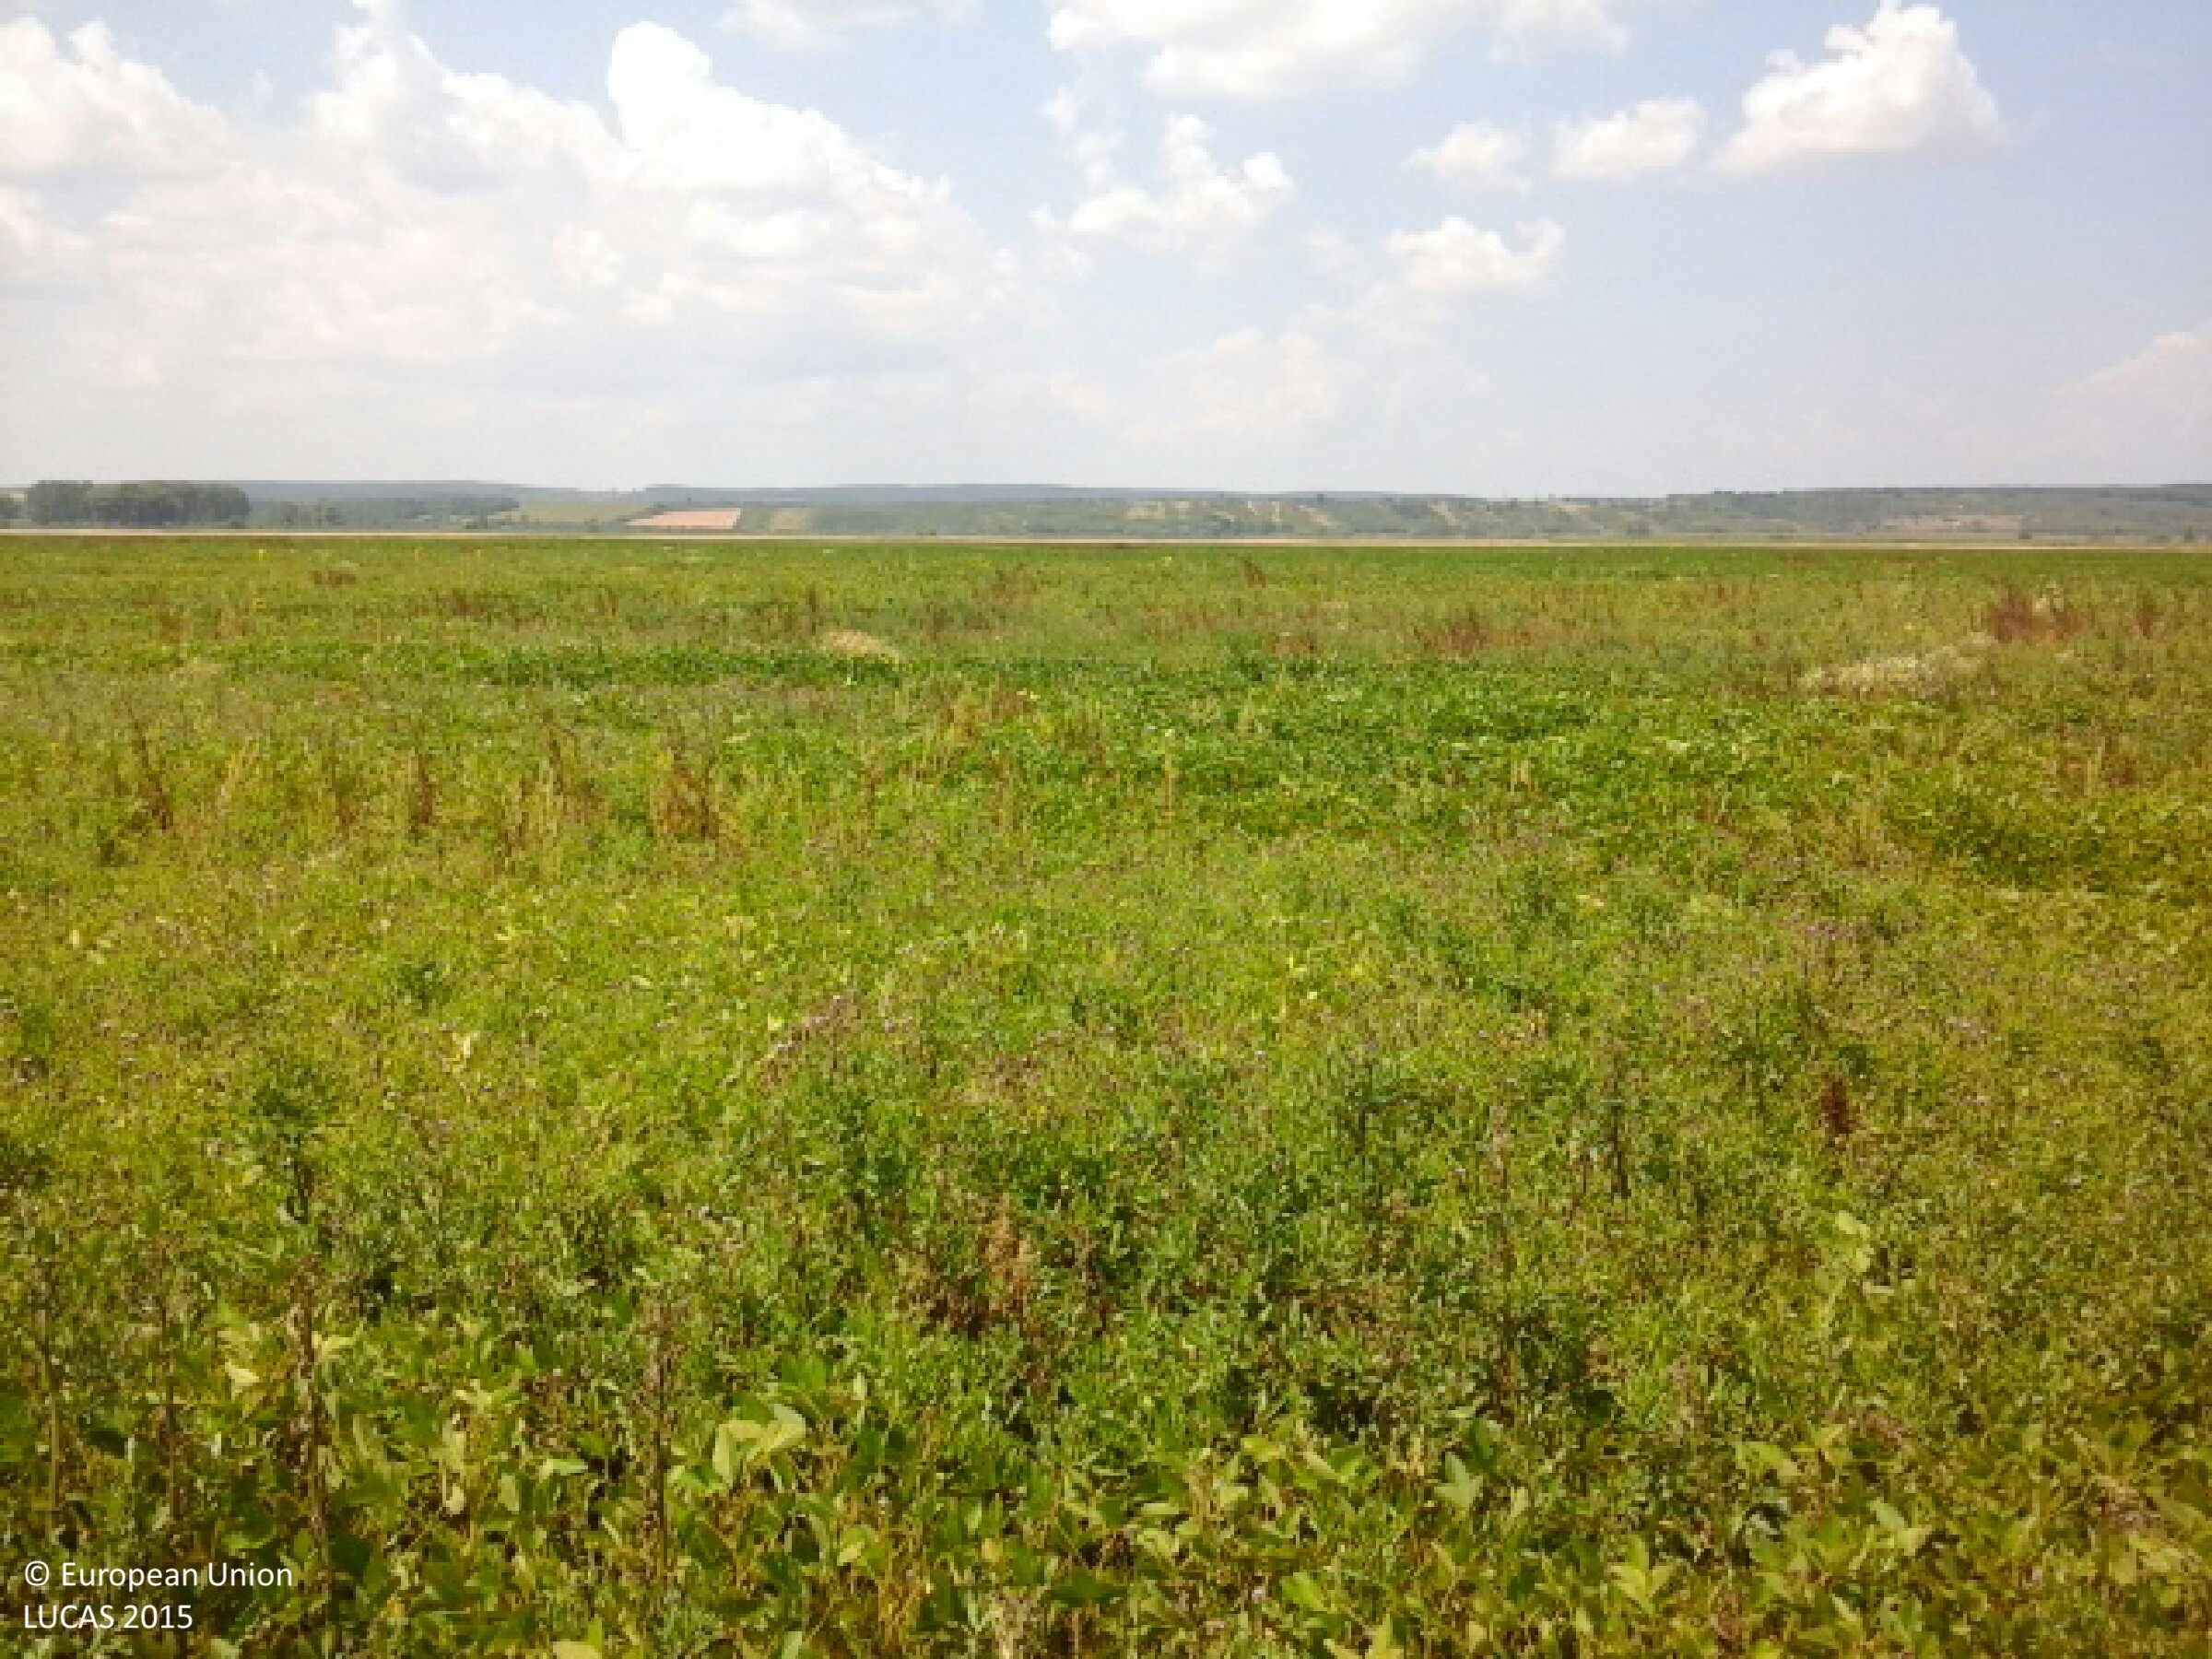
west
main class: Cropland
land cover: Soya
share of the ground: > 75 %
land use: Agriculture (excluding fallow land and kitchen gardens)
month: July
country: HU
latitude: 48.3793
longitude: 21.1814
